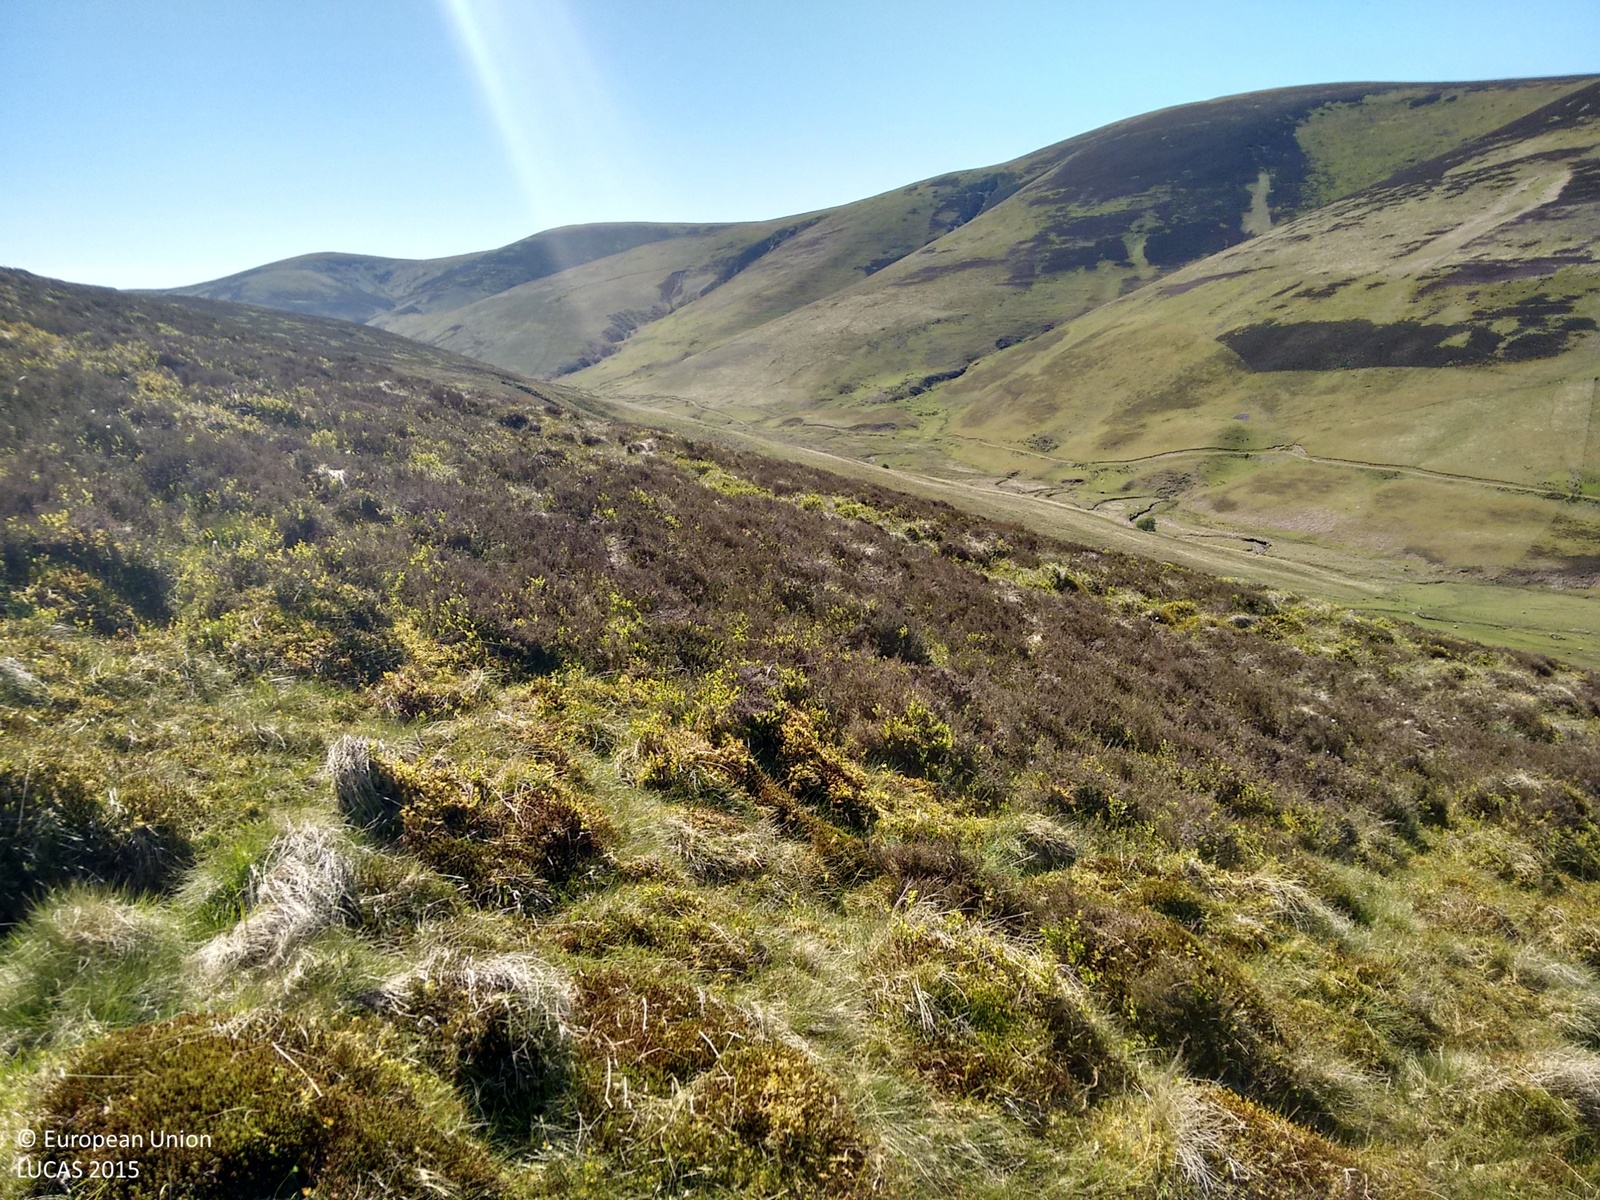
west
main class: Shrubland
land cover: Shrubland without tree cover
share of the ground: 25 - 50 %
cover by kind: shrubs 45 %, herbaceous plants 45 %, lichens and mosses 10 %
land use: Semi-natural and natural areas not in use
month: June
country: GB
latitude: 55.5109
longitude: -3.4588
